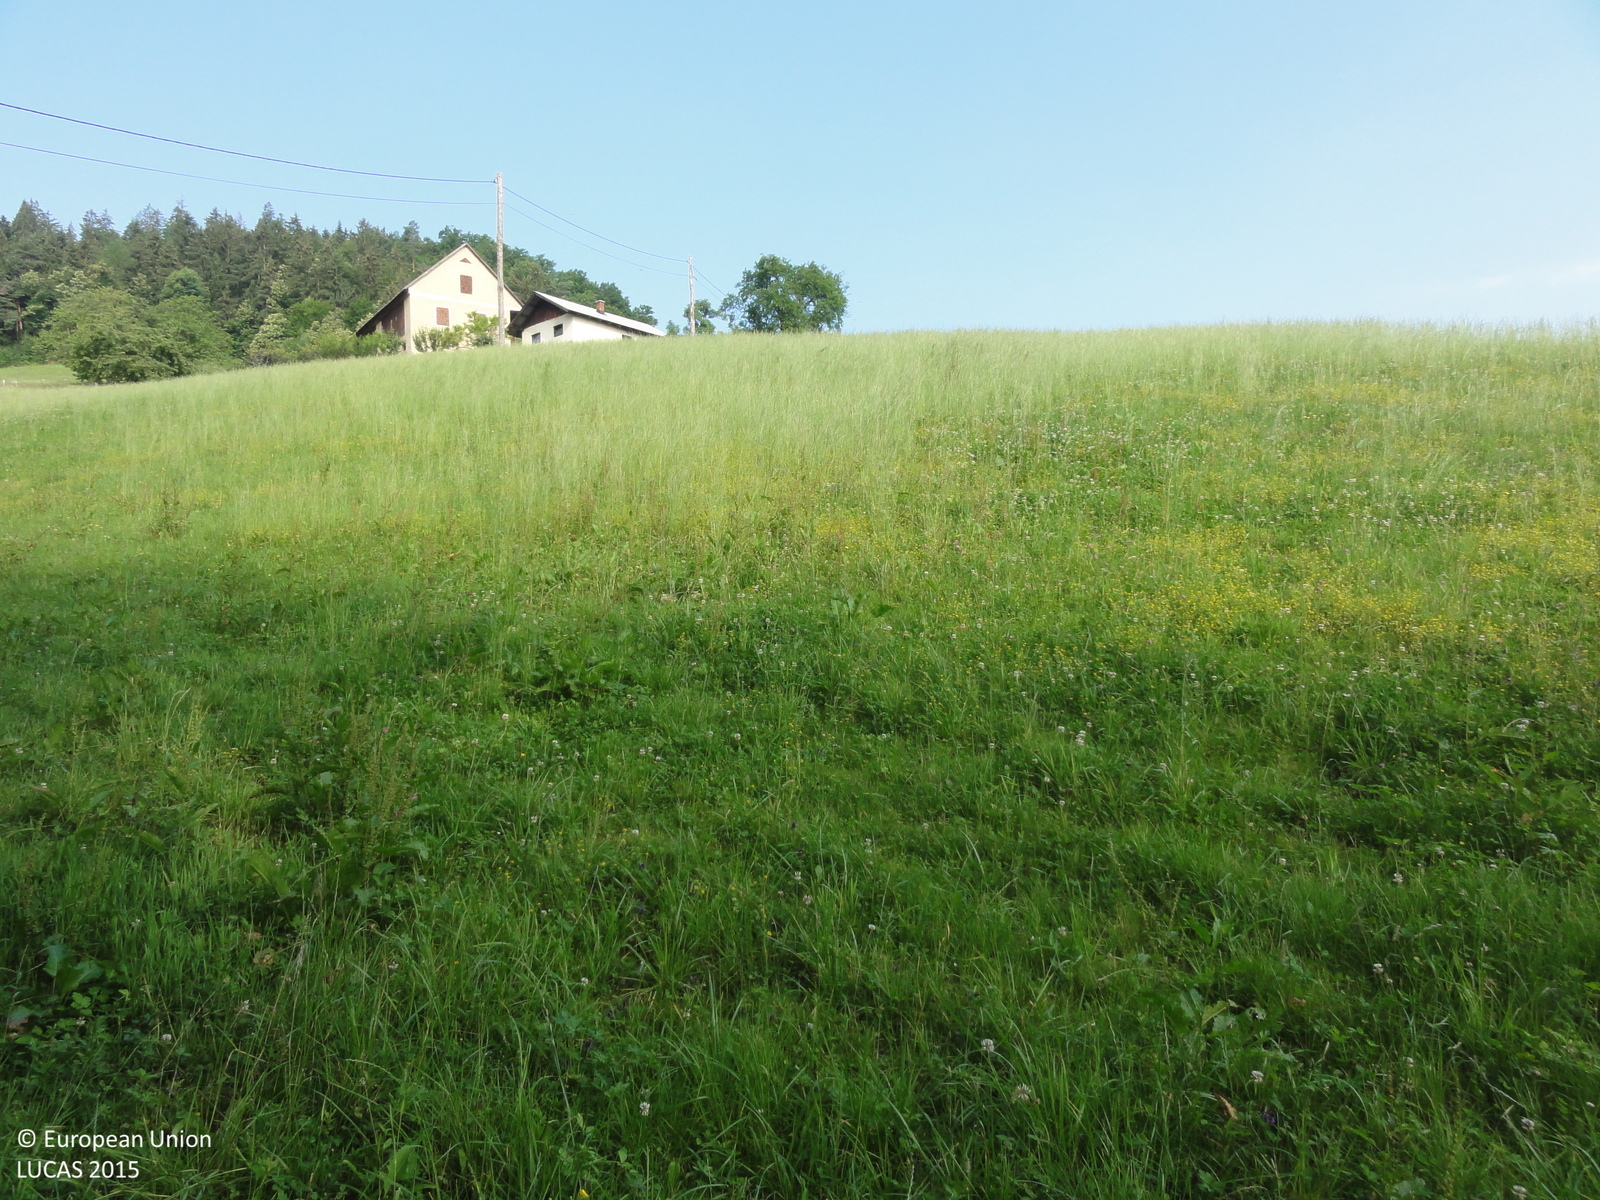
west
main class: Shrubland
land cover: Shrubland with sparse tree cover
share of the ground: > 75 %
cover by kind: shrubs 95 %, broadleaved forest trees 5 %
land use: Forestry
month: July
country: SI
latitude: 46.6223
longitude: 15.5494
